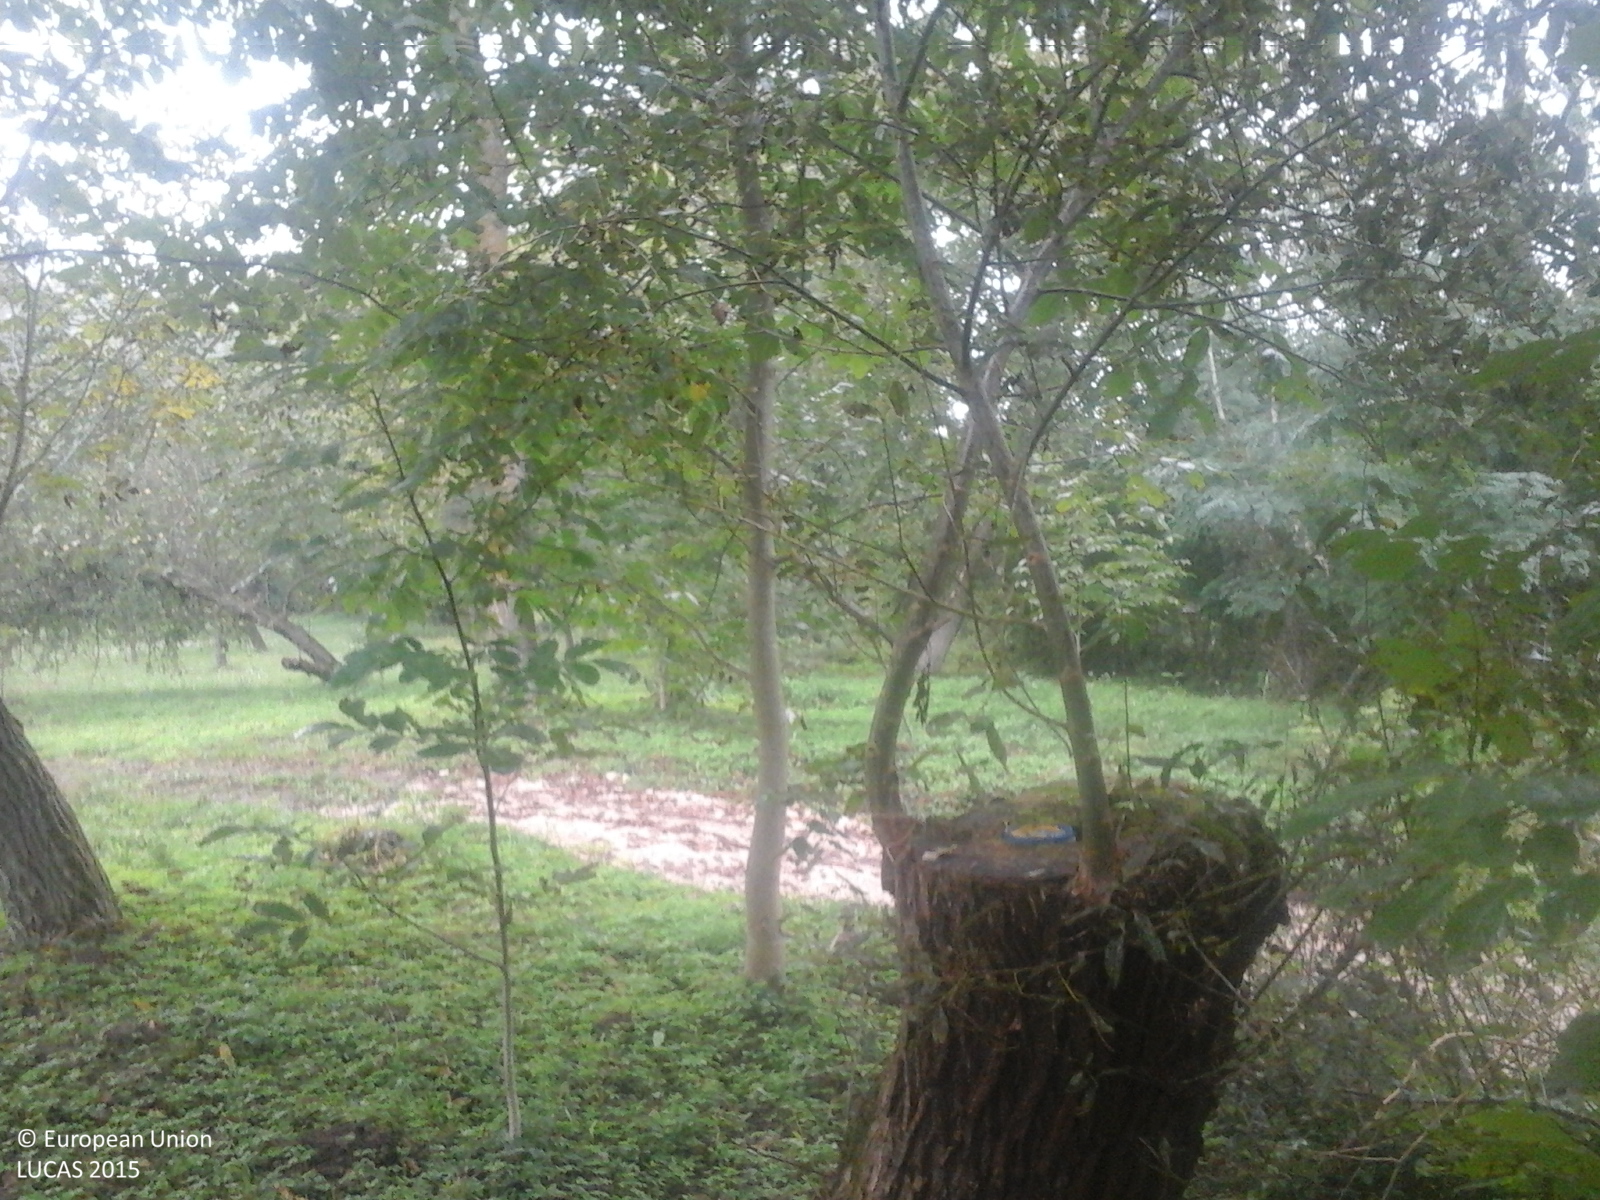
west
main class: Cropland
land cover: Nuts trees
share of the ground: > 75 %
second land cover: Grassland without tree/shrub cover
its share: < 10 %
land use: Agriculture (excluding fallow land and kitchen gardens)
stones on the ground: < 10 %
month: October
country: RO
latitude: 46.3510
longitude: 23.6225
